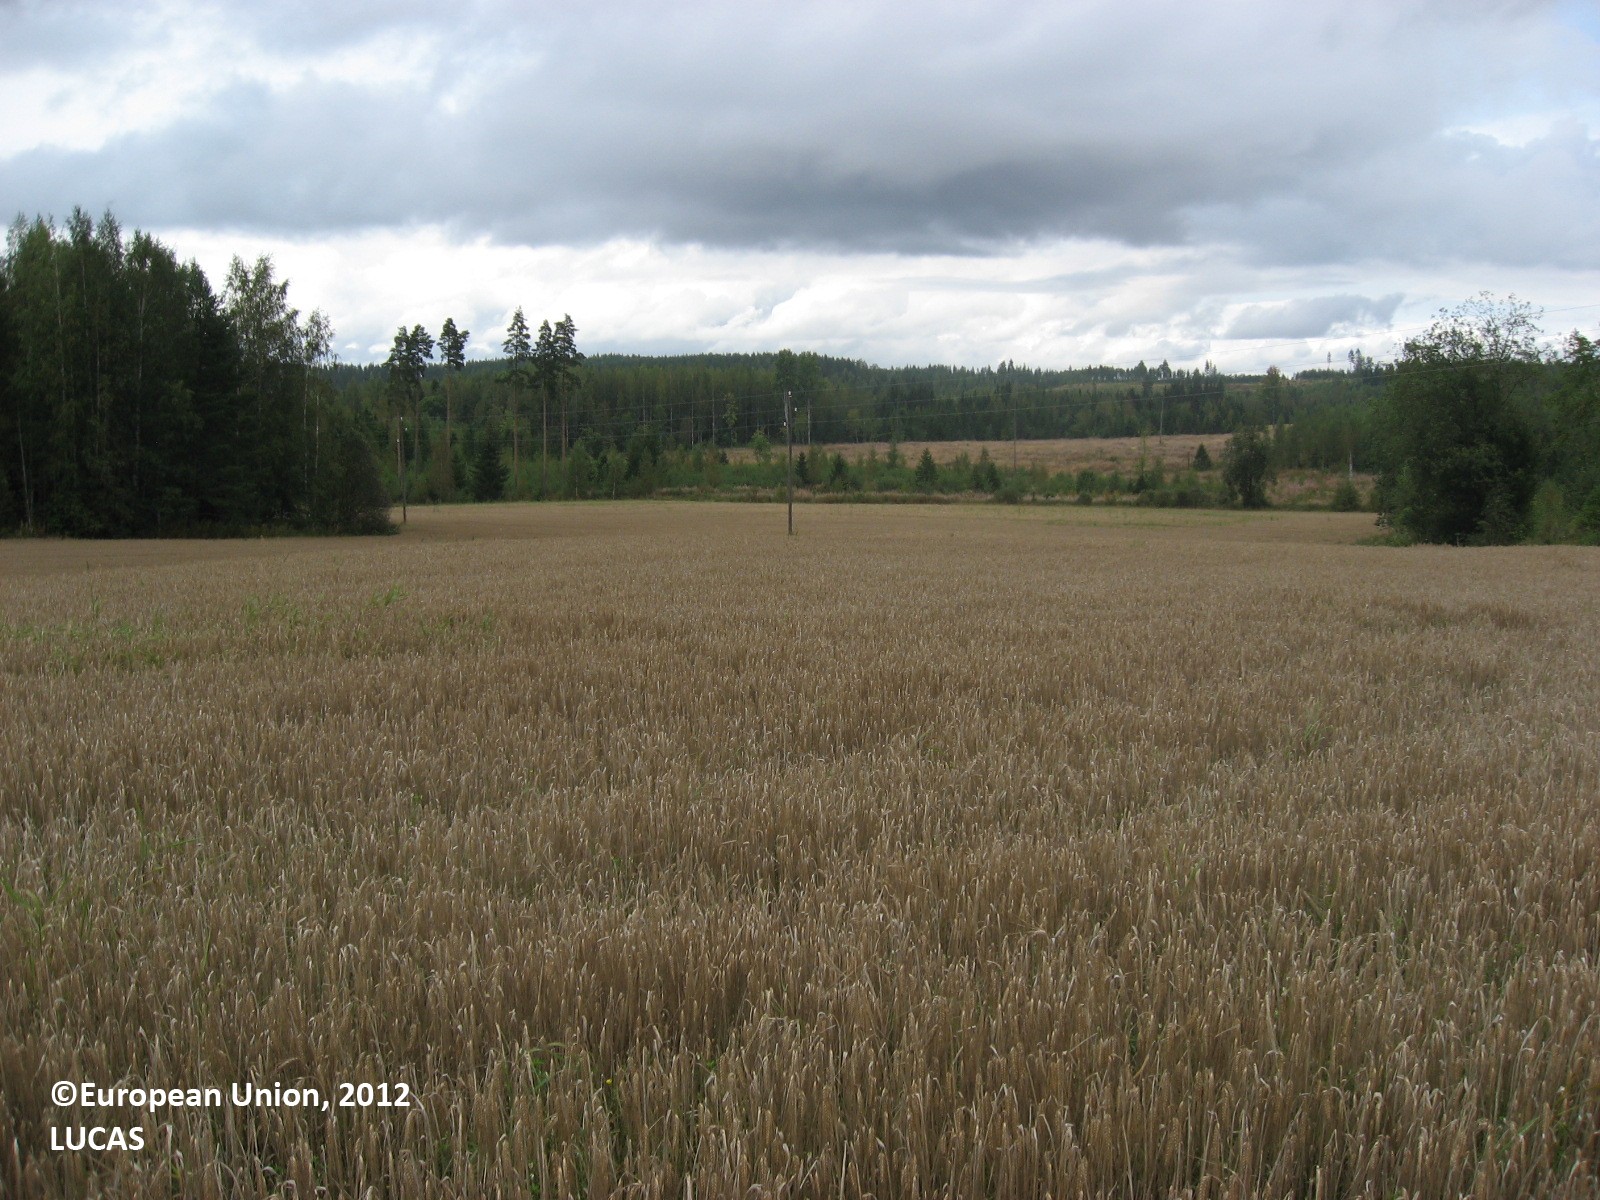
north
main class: Cropland
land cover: Barley
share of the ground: > 75 %
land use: Agriculture (excluding fallow land and kitchen gardens)
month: September
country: FI
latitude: 60.9848
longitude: 25.2185
